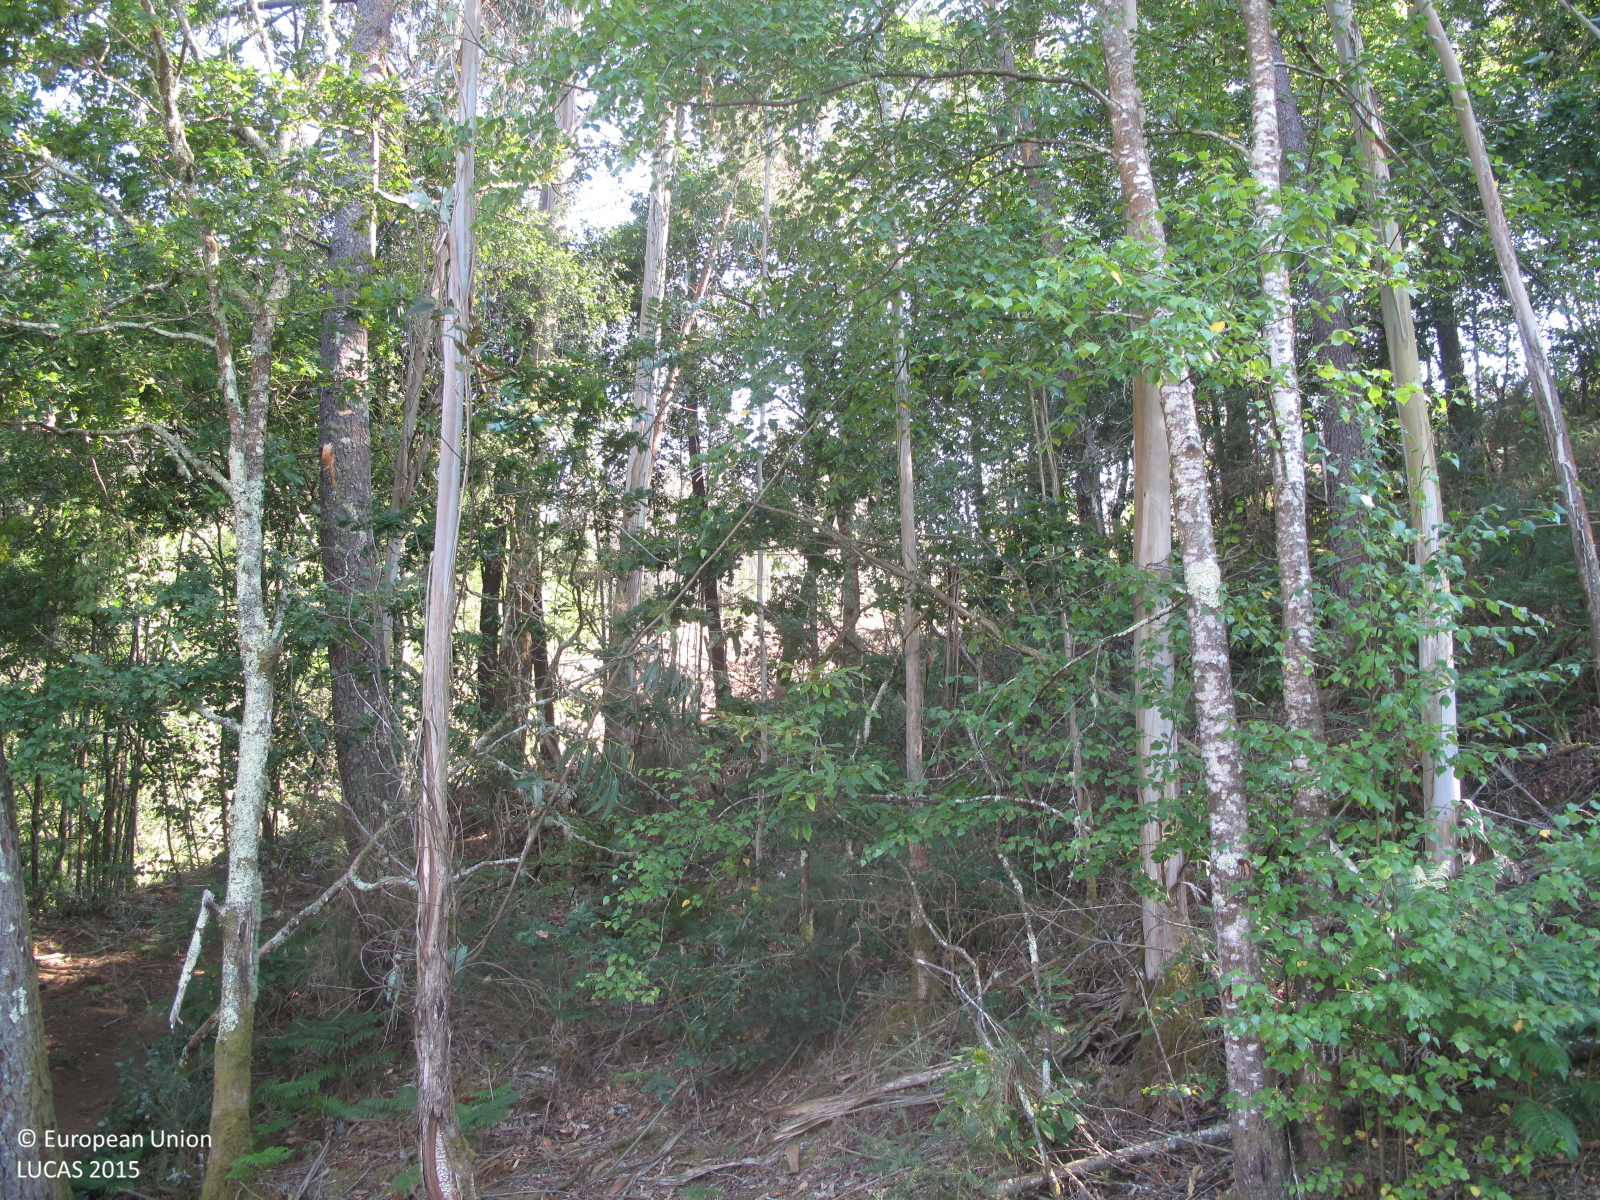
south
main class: Grassland
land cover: Grassland with sparse tree/shrub cover
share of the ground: 50 - 75 %
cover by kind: herbaceous plants 70 %, unconsolidated bare surface 20 %, broadleaved forest trees 5 %, shrubs 5 %
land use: Forestry
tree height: < 5 m
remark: Clear cut
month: July
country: ES
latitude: 43.3518
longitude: -8.0974
